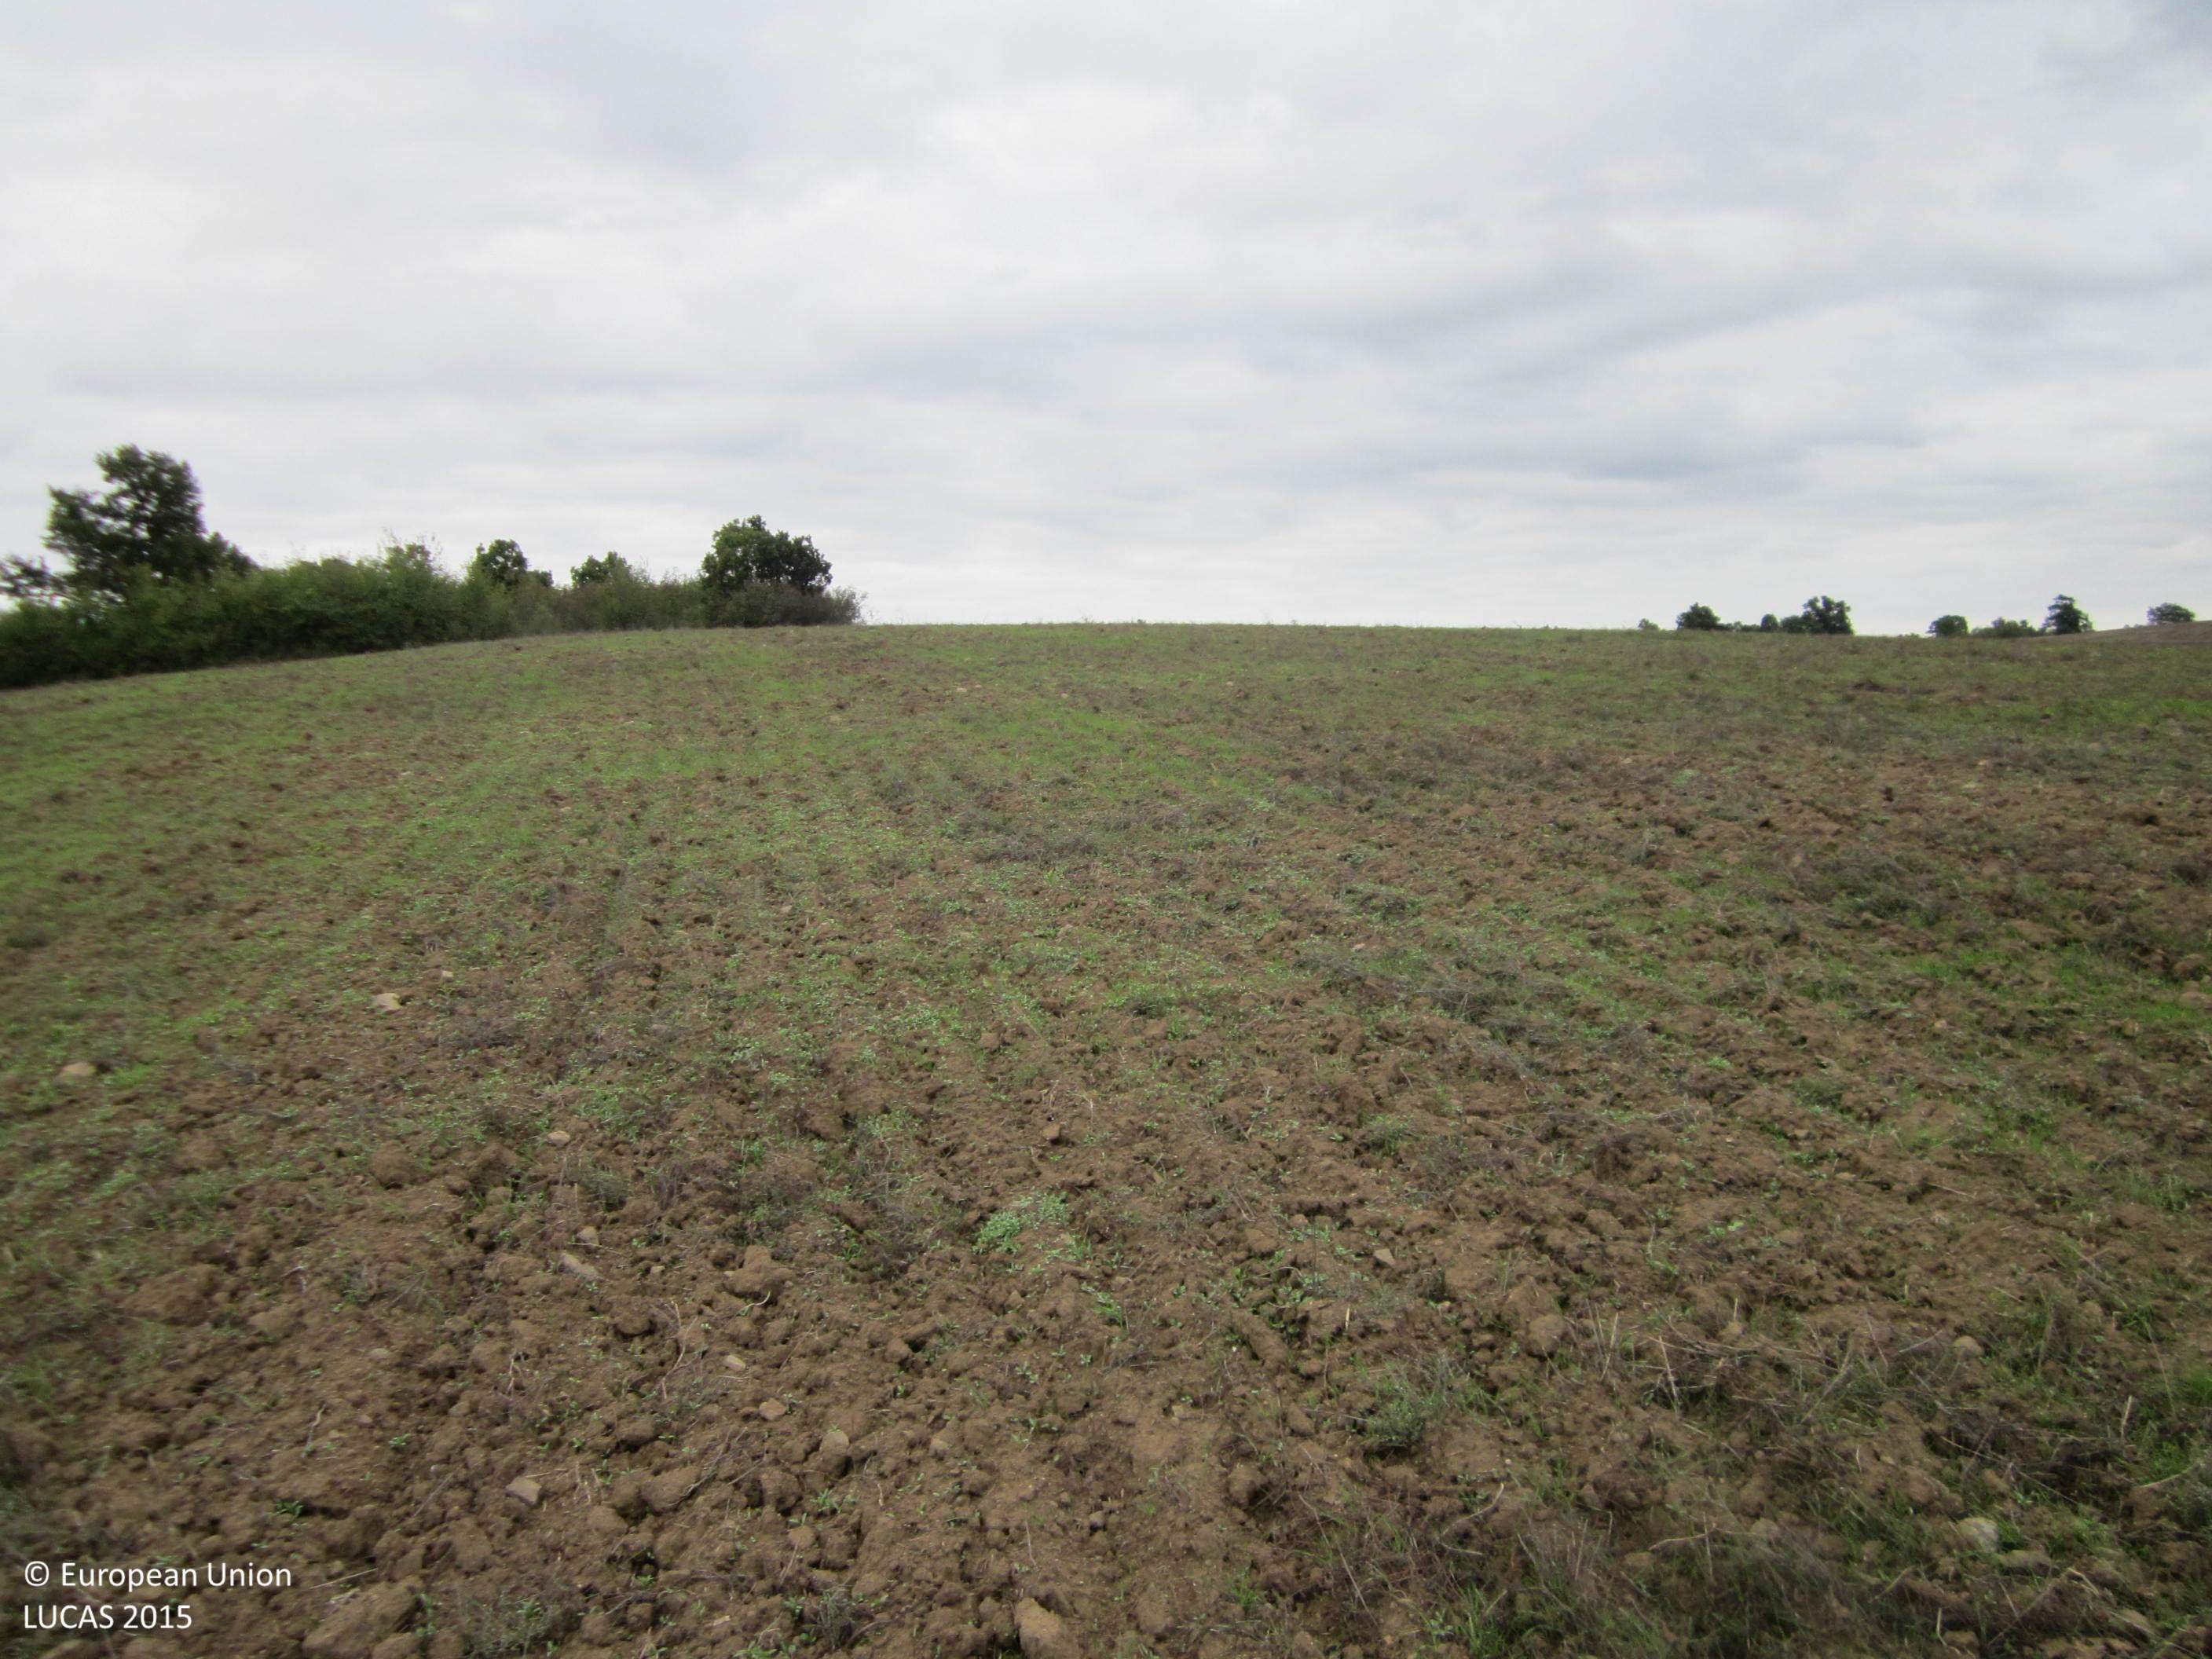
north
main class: Cropland
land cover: Common wheat
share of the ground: 10 - 25 %
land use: Agriculture (excluding fallow land and kitchen gardens)
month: October
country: BG
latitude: 42.3454
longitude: 27.1117
